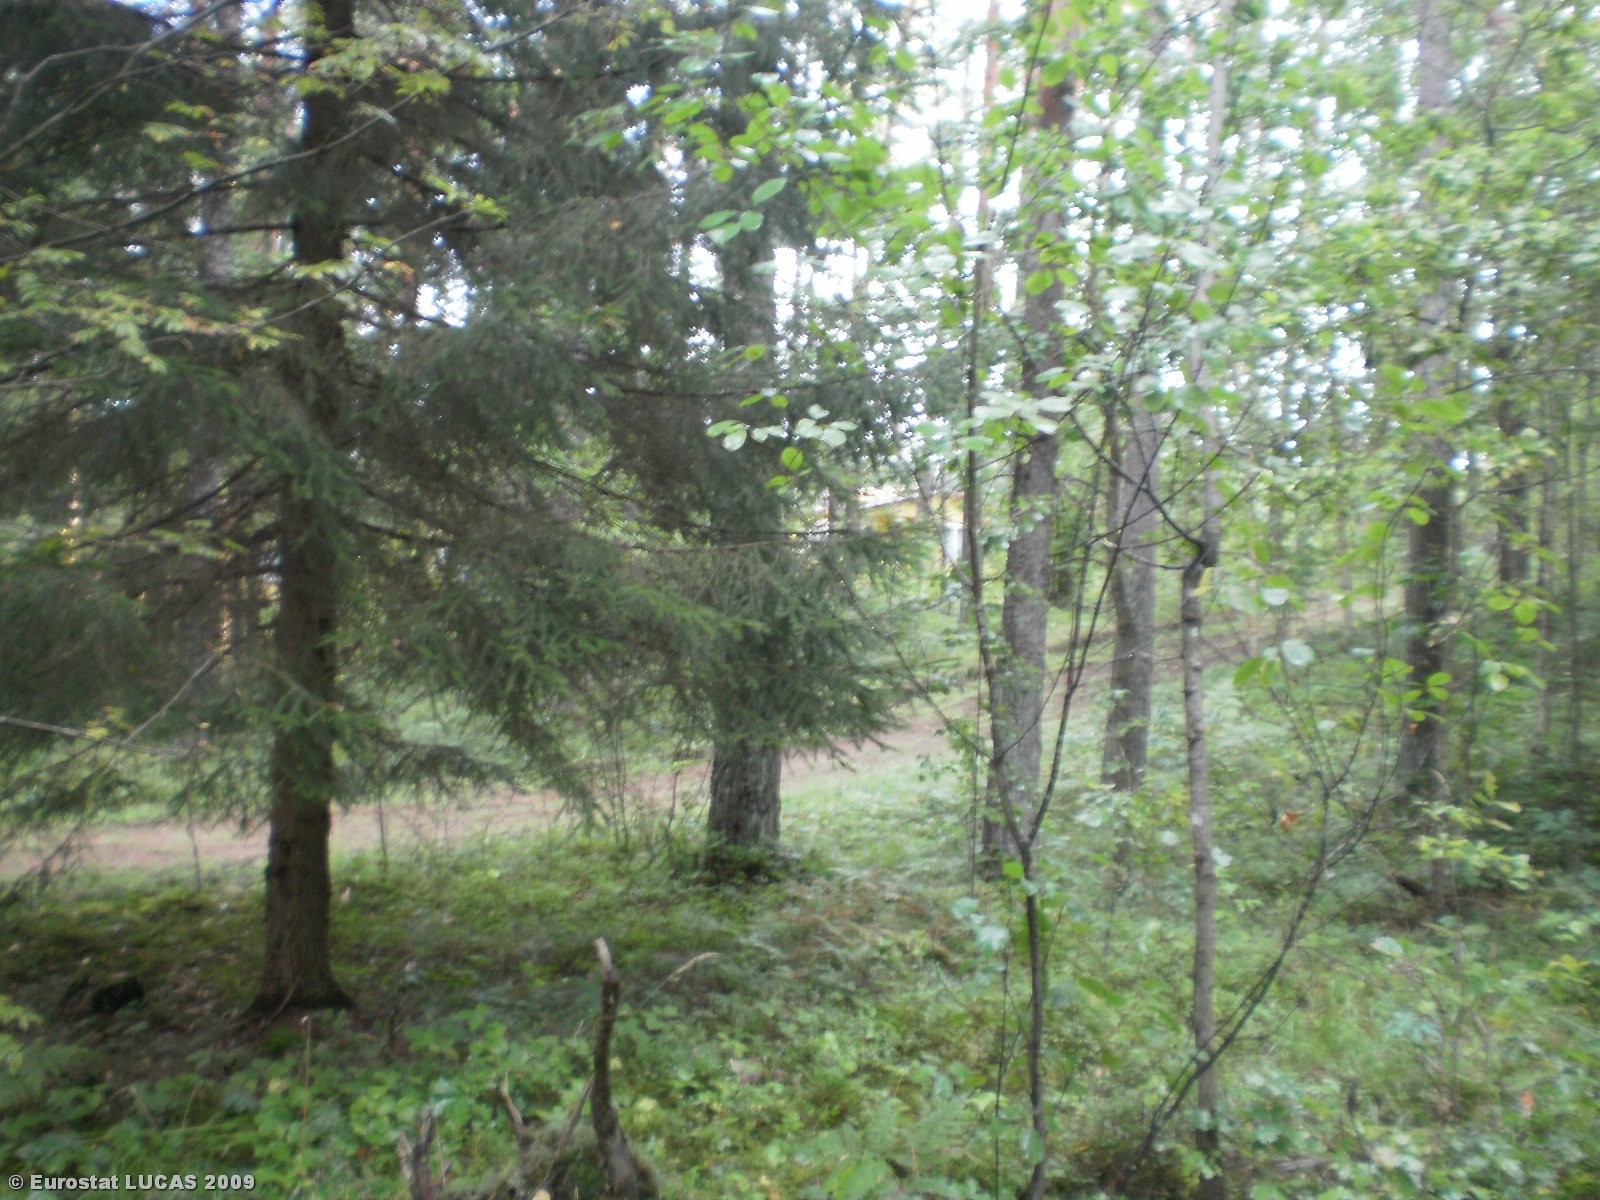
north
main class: Woodland
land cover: Mixed woodland
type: hemiboreal forest and nemoral coniferous forest and mixed broadleaved-coniferous forest
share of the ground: > 75 %
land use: Forestry
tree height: > 5 m
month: August
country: LT
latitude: 55.0522
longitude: 25.5135
